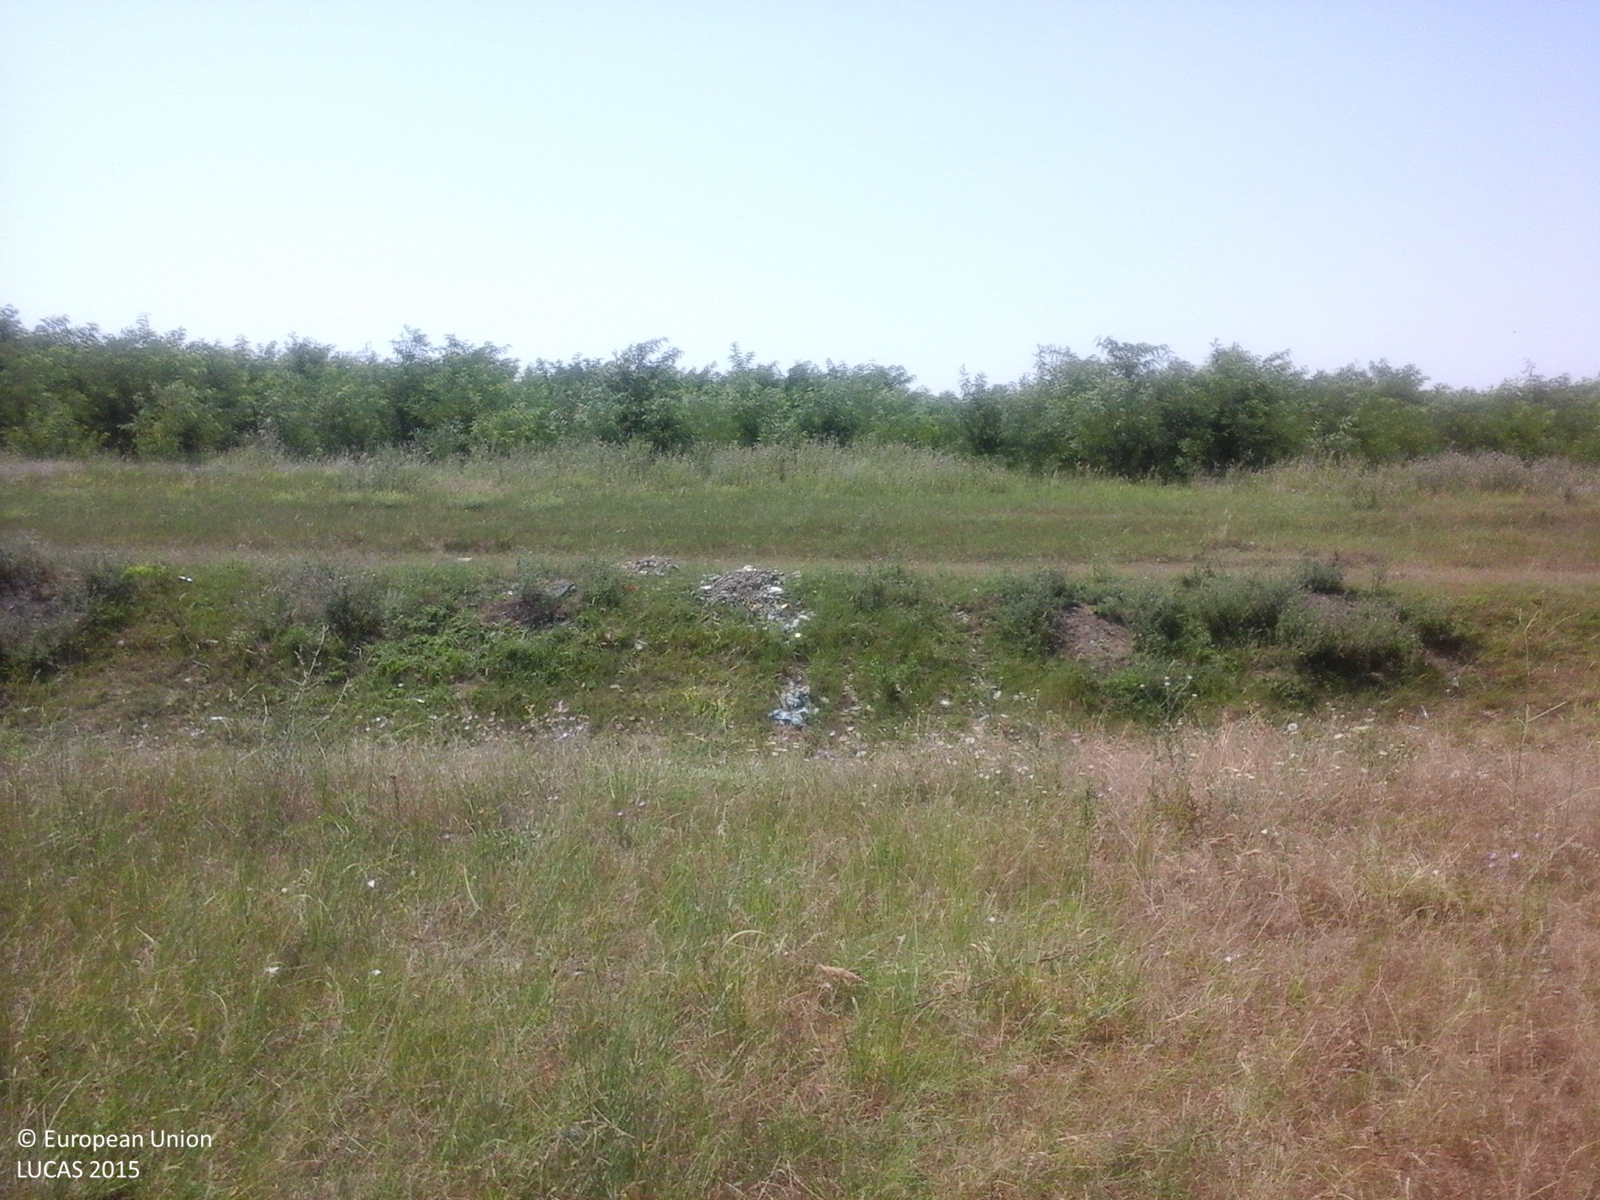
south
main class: Cropland
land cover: Maize
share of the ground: > 75 %
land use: Agriculture (excluding fallow land and kitchen gardens)
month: July
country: RO
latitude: 44.4665
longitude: 26.7517
